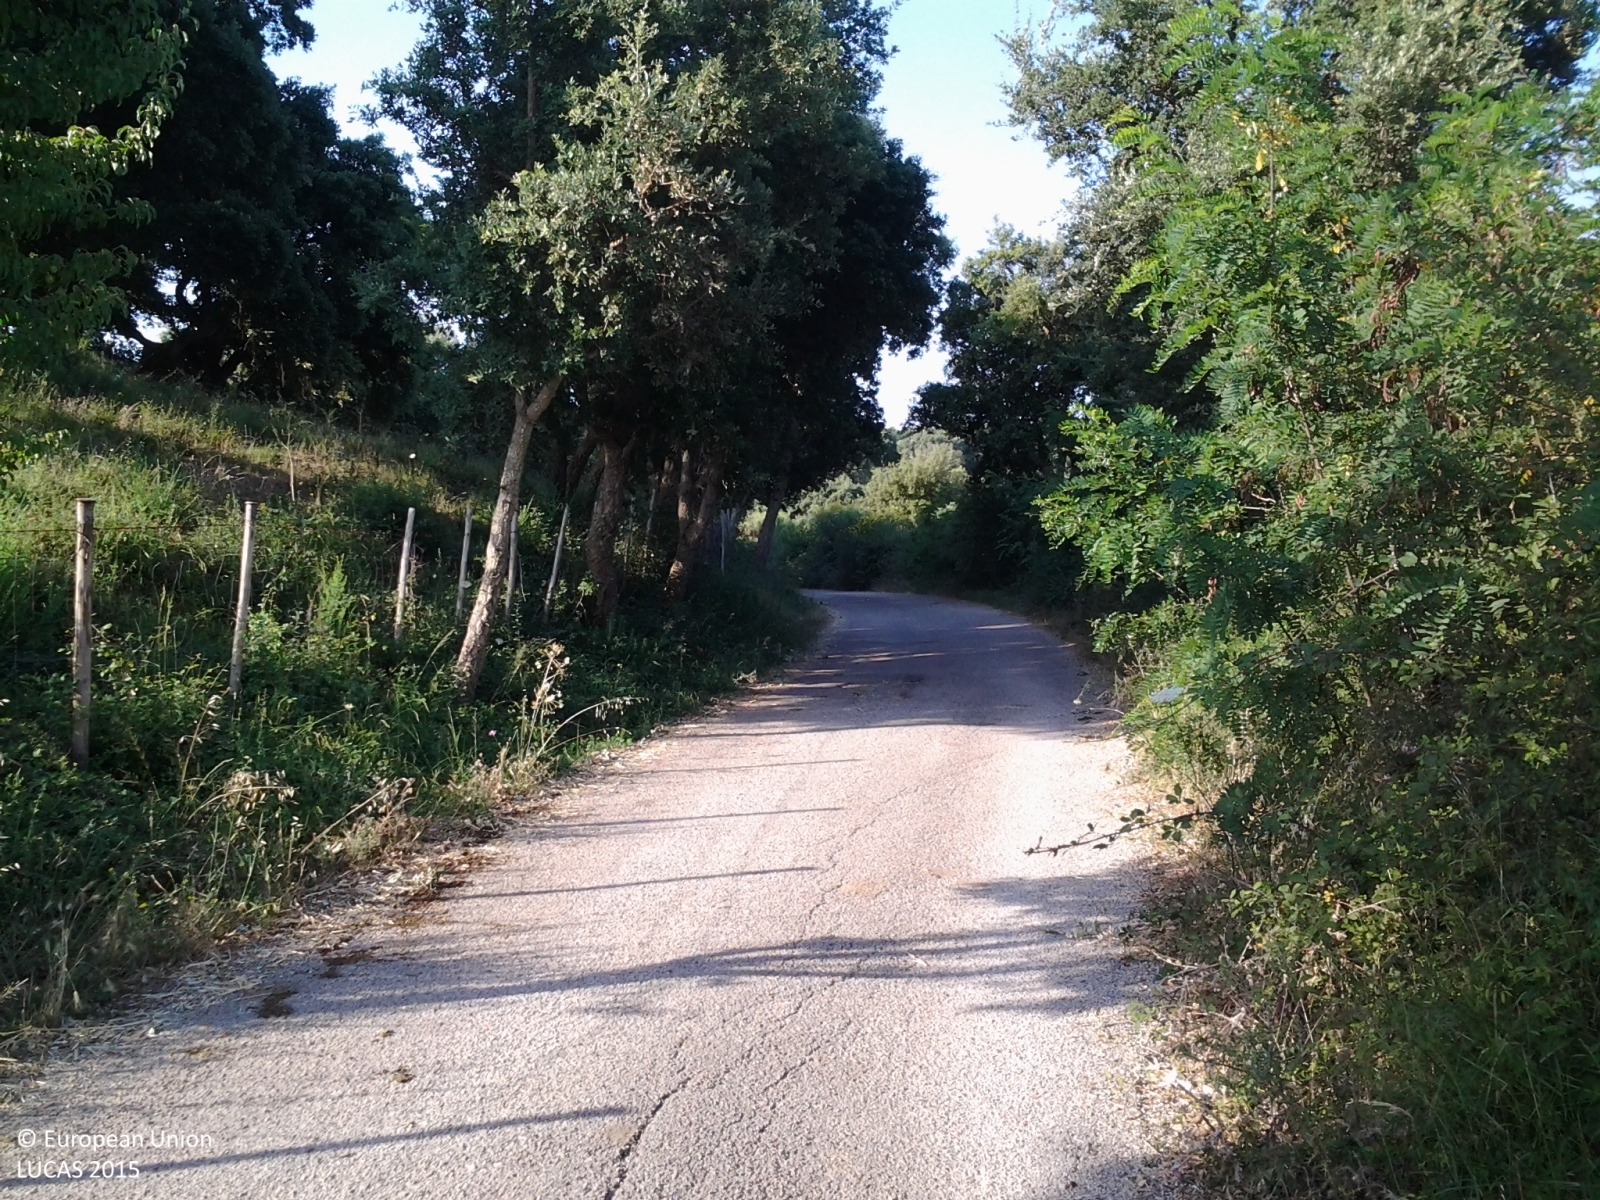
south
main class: Woodland
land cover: Broadleaved woodland
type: broadleaved evergreen forest
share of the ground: > 75 %
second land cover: Grassland without tree/shrub cover
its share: > 75 %
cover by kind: broadleaved forest trees 80 %, herbaceous plants 15 %, shrubs 5 %
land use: Forestry
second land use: Agriculture (excluding fallow land and kitchen gardens)
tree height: < 5 m
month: July
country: IT
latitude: 38.0060
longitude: 14.4681
